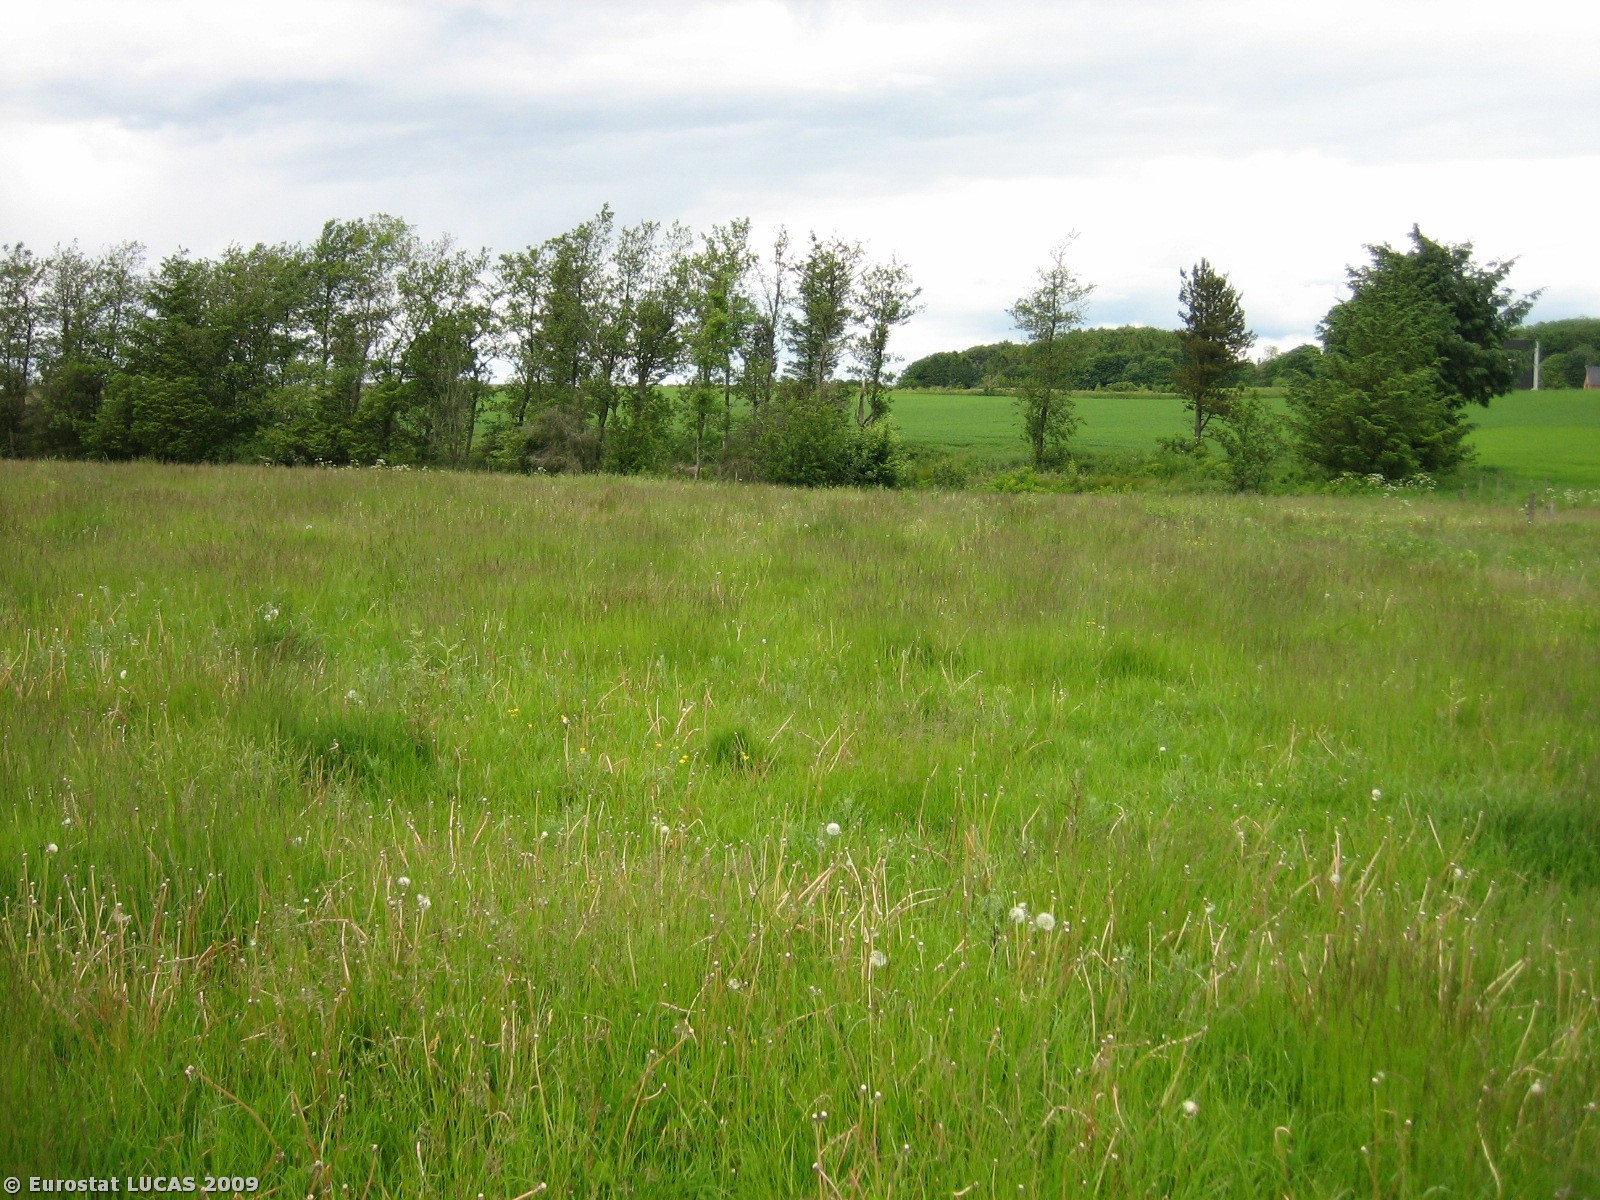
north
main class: Grassland
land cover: Grassland without tree/shrub cover
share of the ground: > 75 %
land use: Agriculture (excluding fallow land and kitchen gardens)
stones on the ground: < 10 %
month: June
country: DK
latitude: 56.2956
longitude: 9.9193
